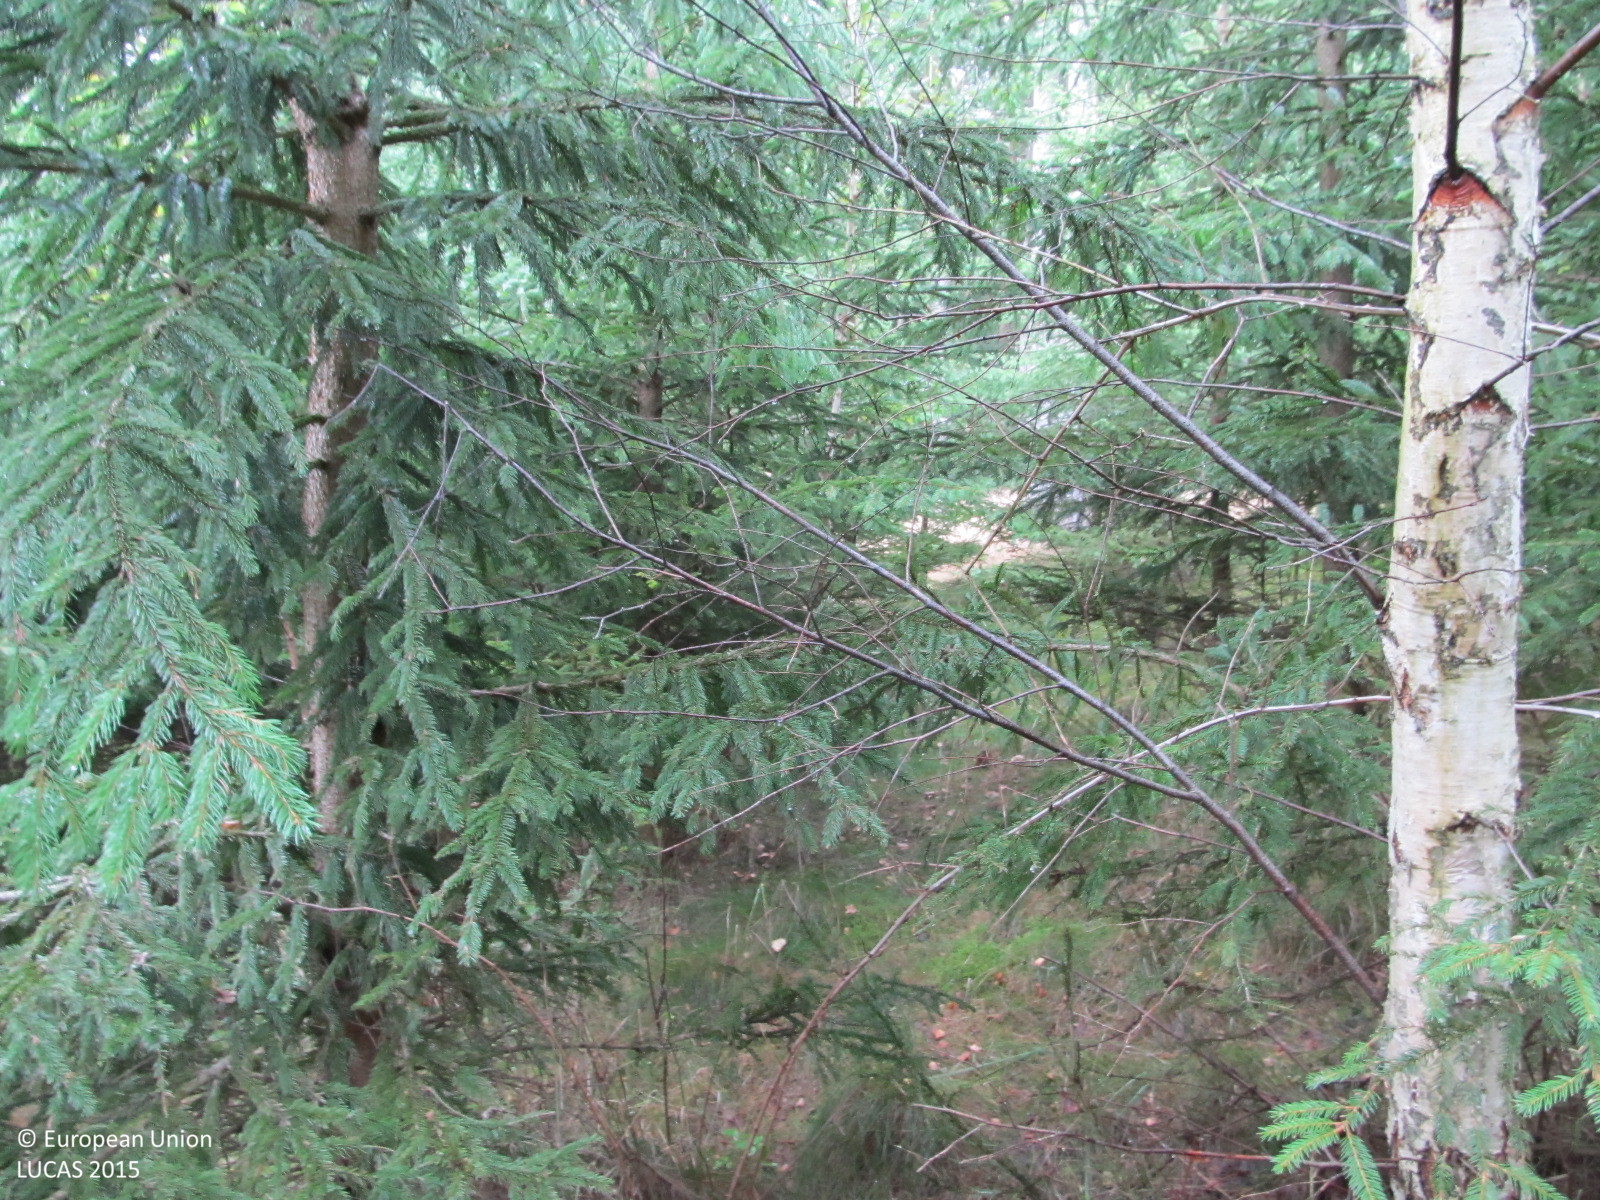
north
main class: Woodland
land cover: Spruce dominated coniferous woodland
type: hemiboreal forest and nemoral coniferous forest and mixed broadleaved-coniferous forest
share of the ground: > 75 %
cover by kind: coniferous forest trees 90 %, herbaceous plants 5 %, unconsolidated bare surface 5 %
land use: Forestry
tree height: > 5 m
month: September
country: AT
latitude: 48.3570
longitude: 15.4953
